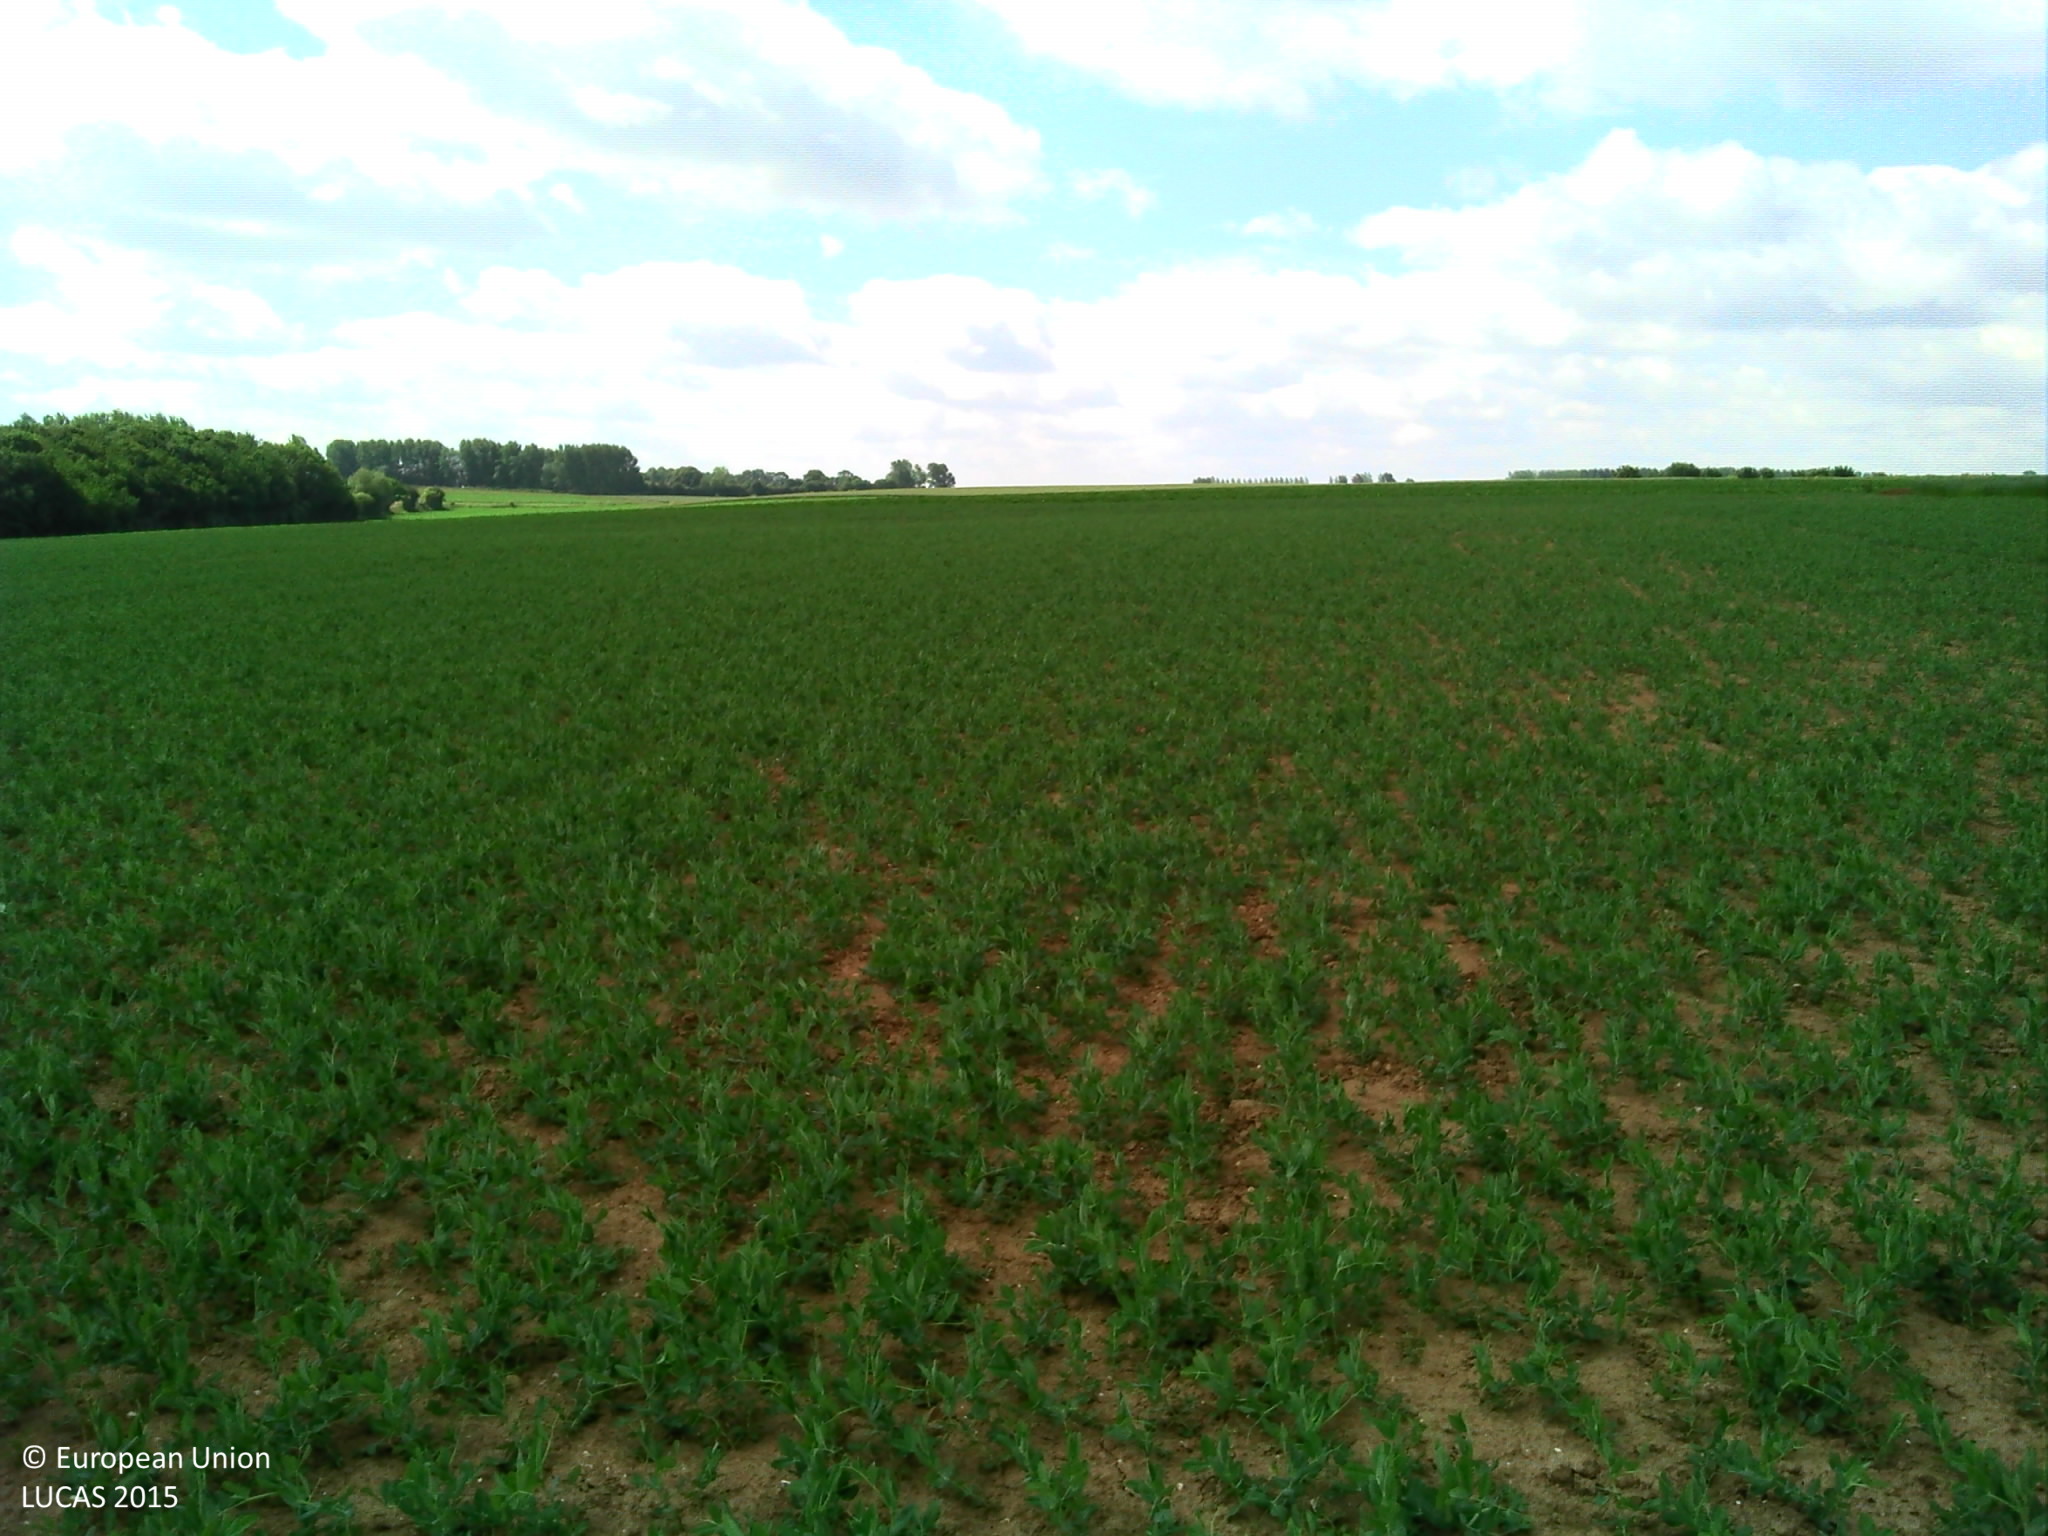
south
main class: Cropland
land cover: Other fresh vegetables
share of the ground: 50 - 75 %
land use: Agriculture (excluding fallow land and kitchen gardens)
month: June
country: FR
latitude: 50.3627
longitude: 2.3816
